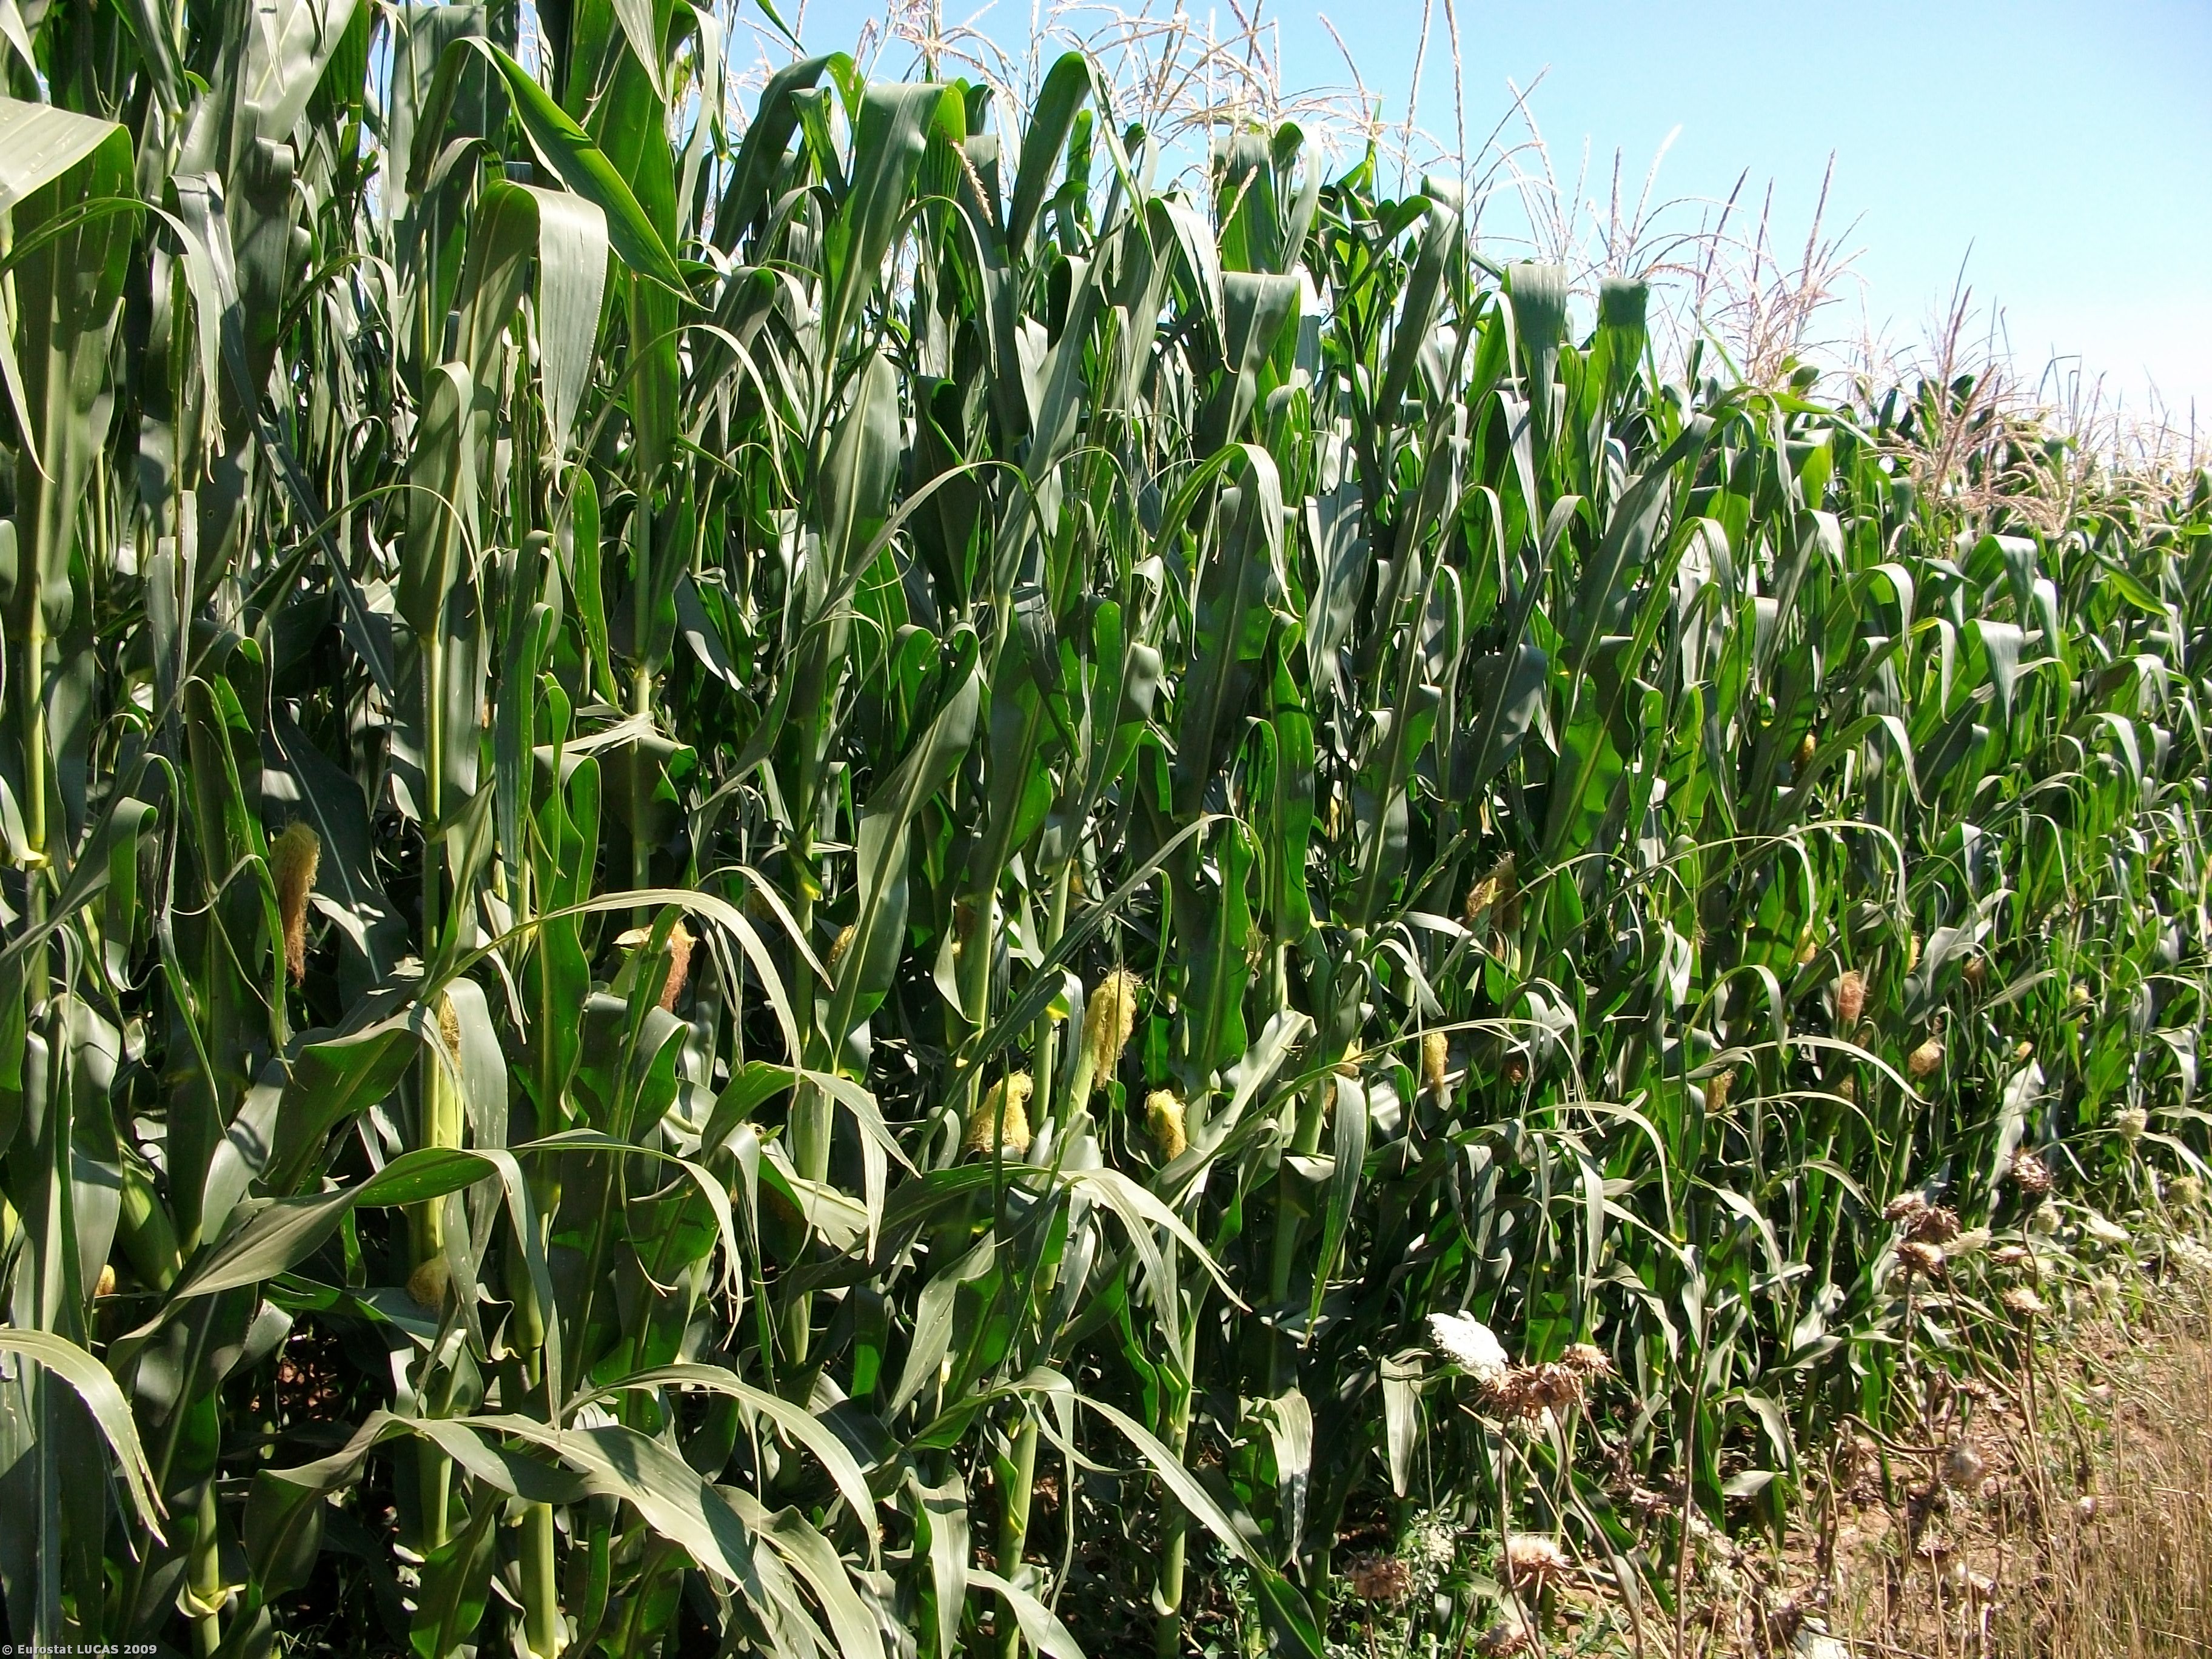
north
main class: Cropland
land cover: Maize
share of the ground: > 75 %
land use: Agriculture (excluding fallow land and kitchen gardens)
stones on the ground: < 10 %
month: July
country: GR
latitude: 39.0889
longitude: 22.4345
